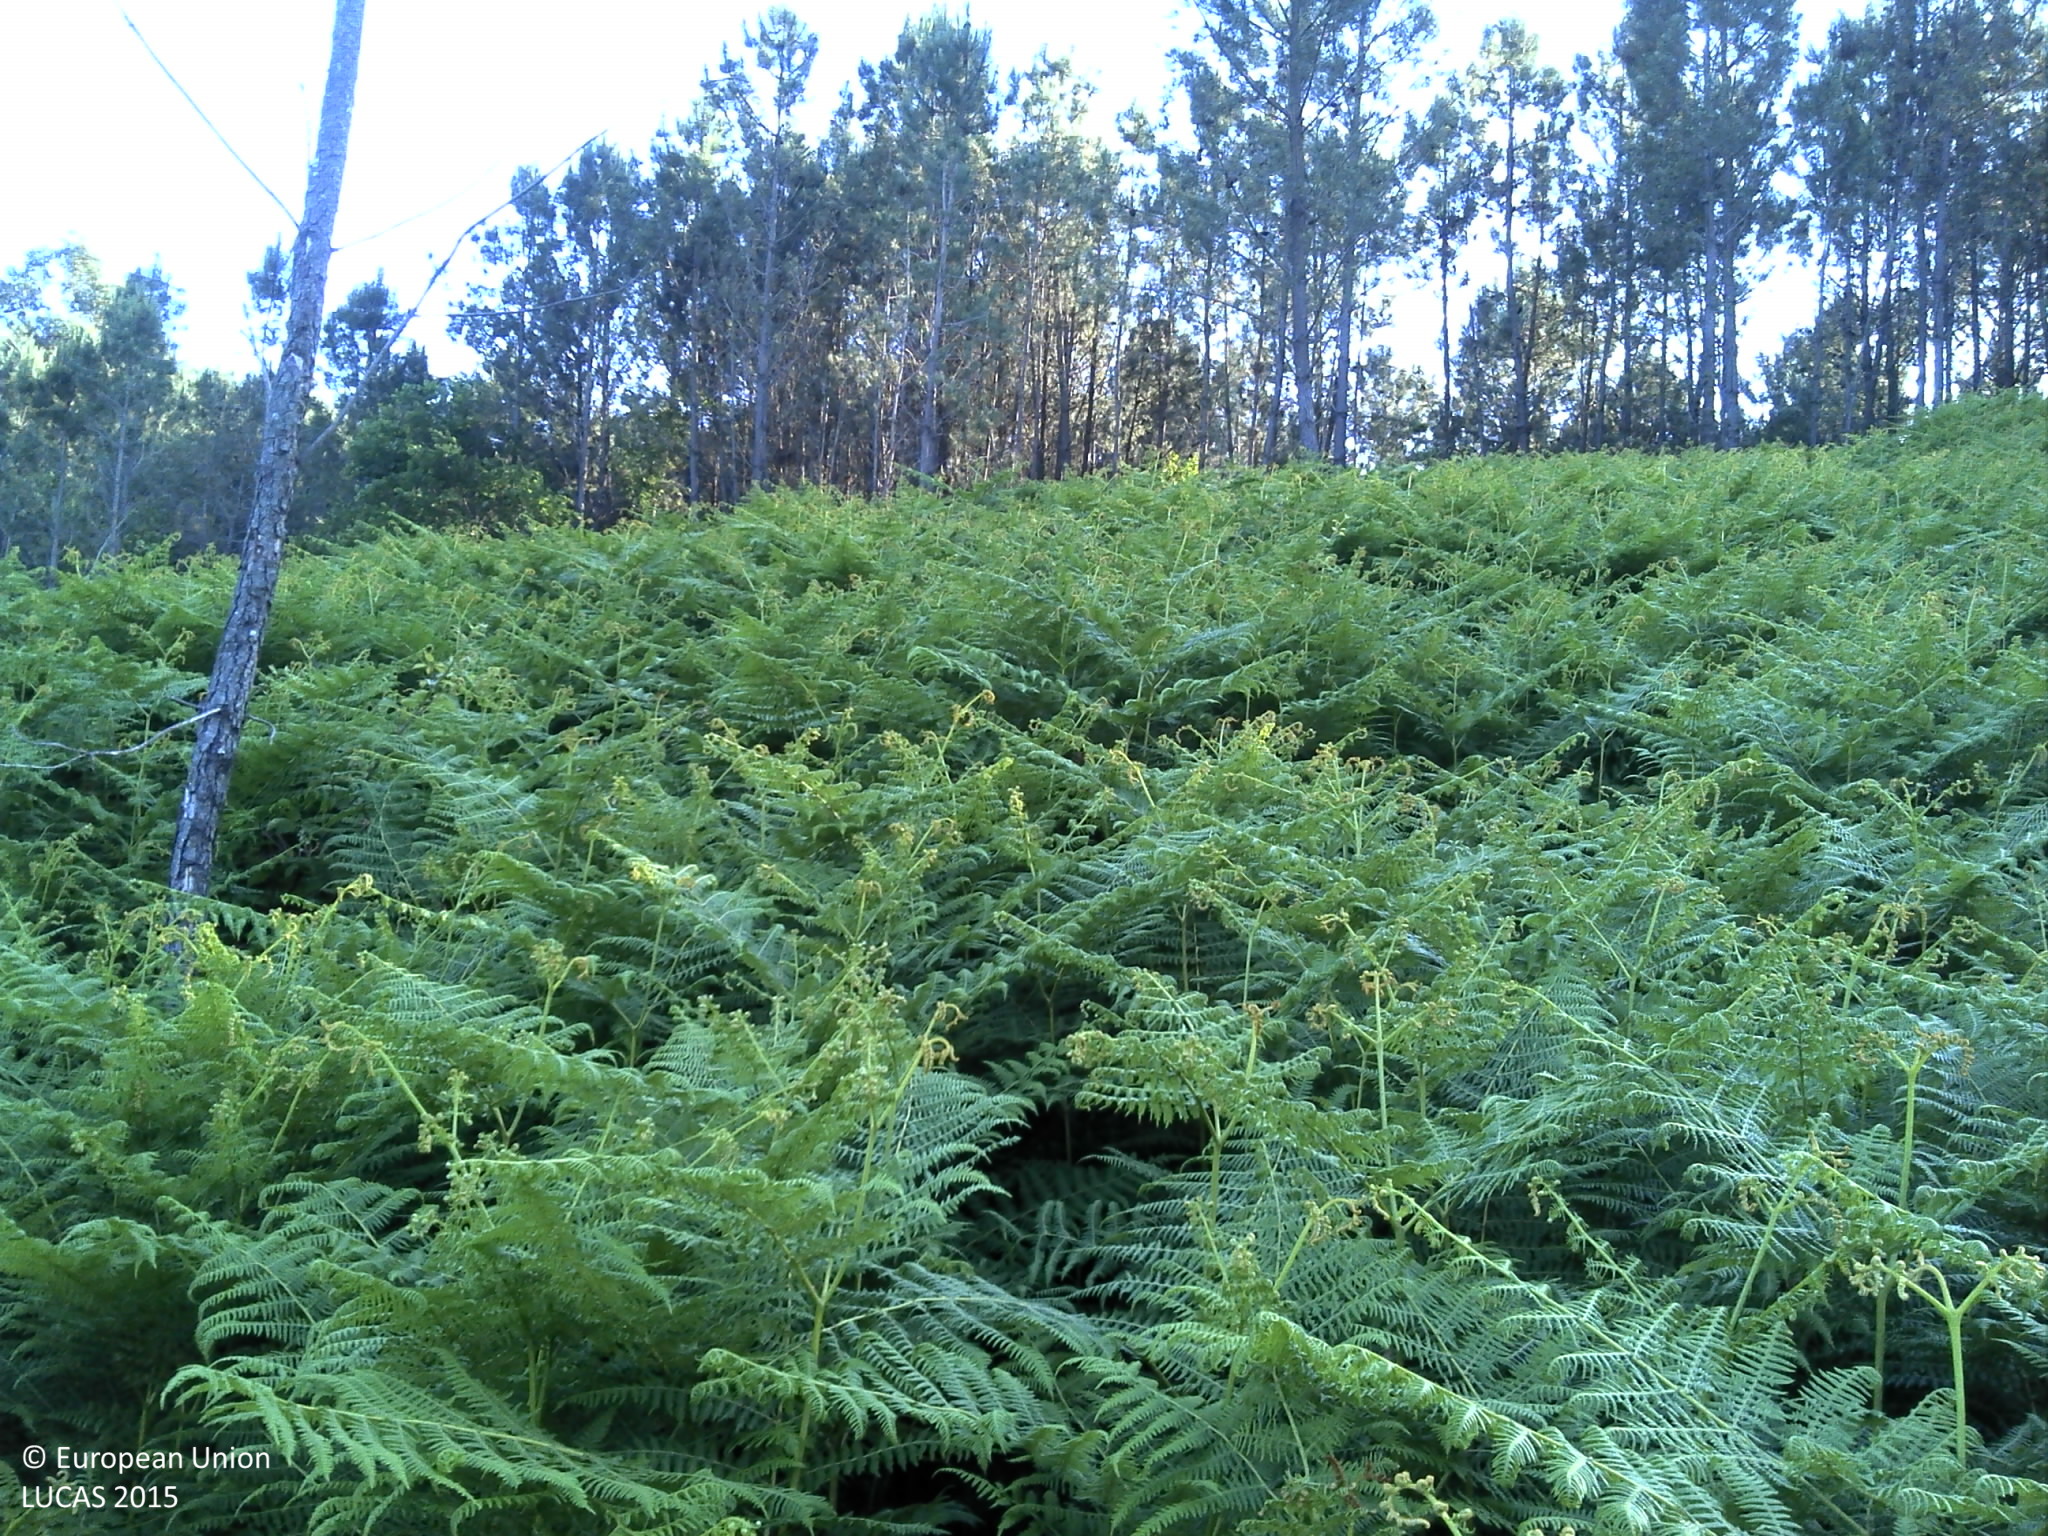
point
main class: Shrubland
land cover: Shrubland without tree cover
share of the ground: > 75 %
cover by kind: shrubs 90 %, herbaceous plants 10 %
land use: Semi-natural and natural areas not in use
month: May
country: PT
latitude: 41.8852
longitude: -8.6402
